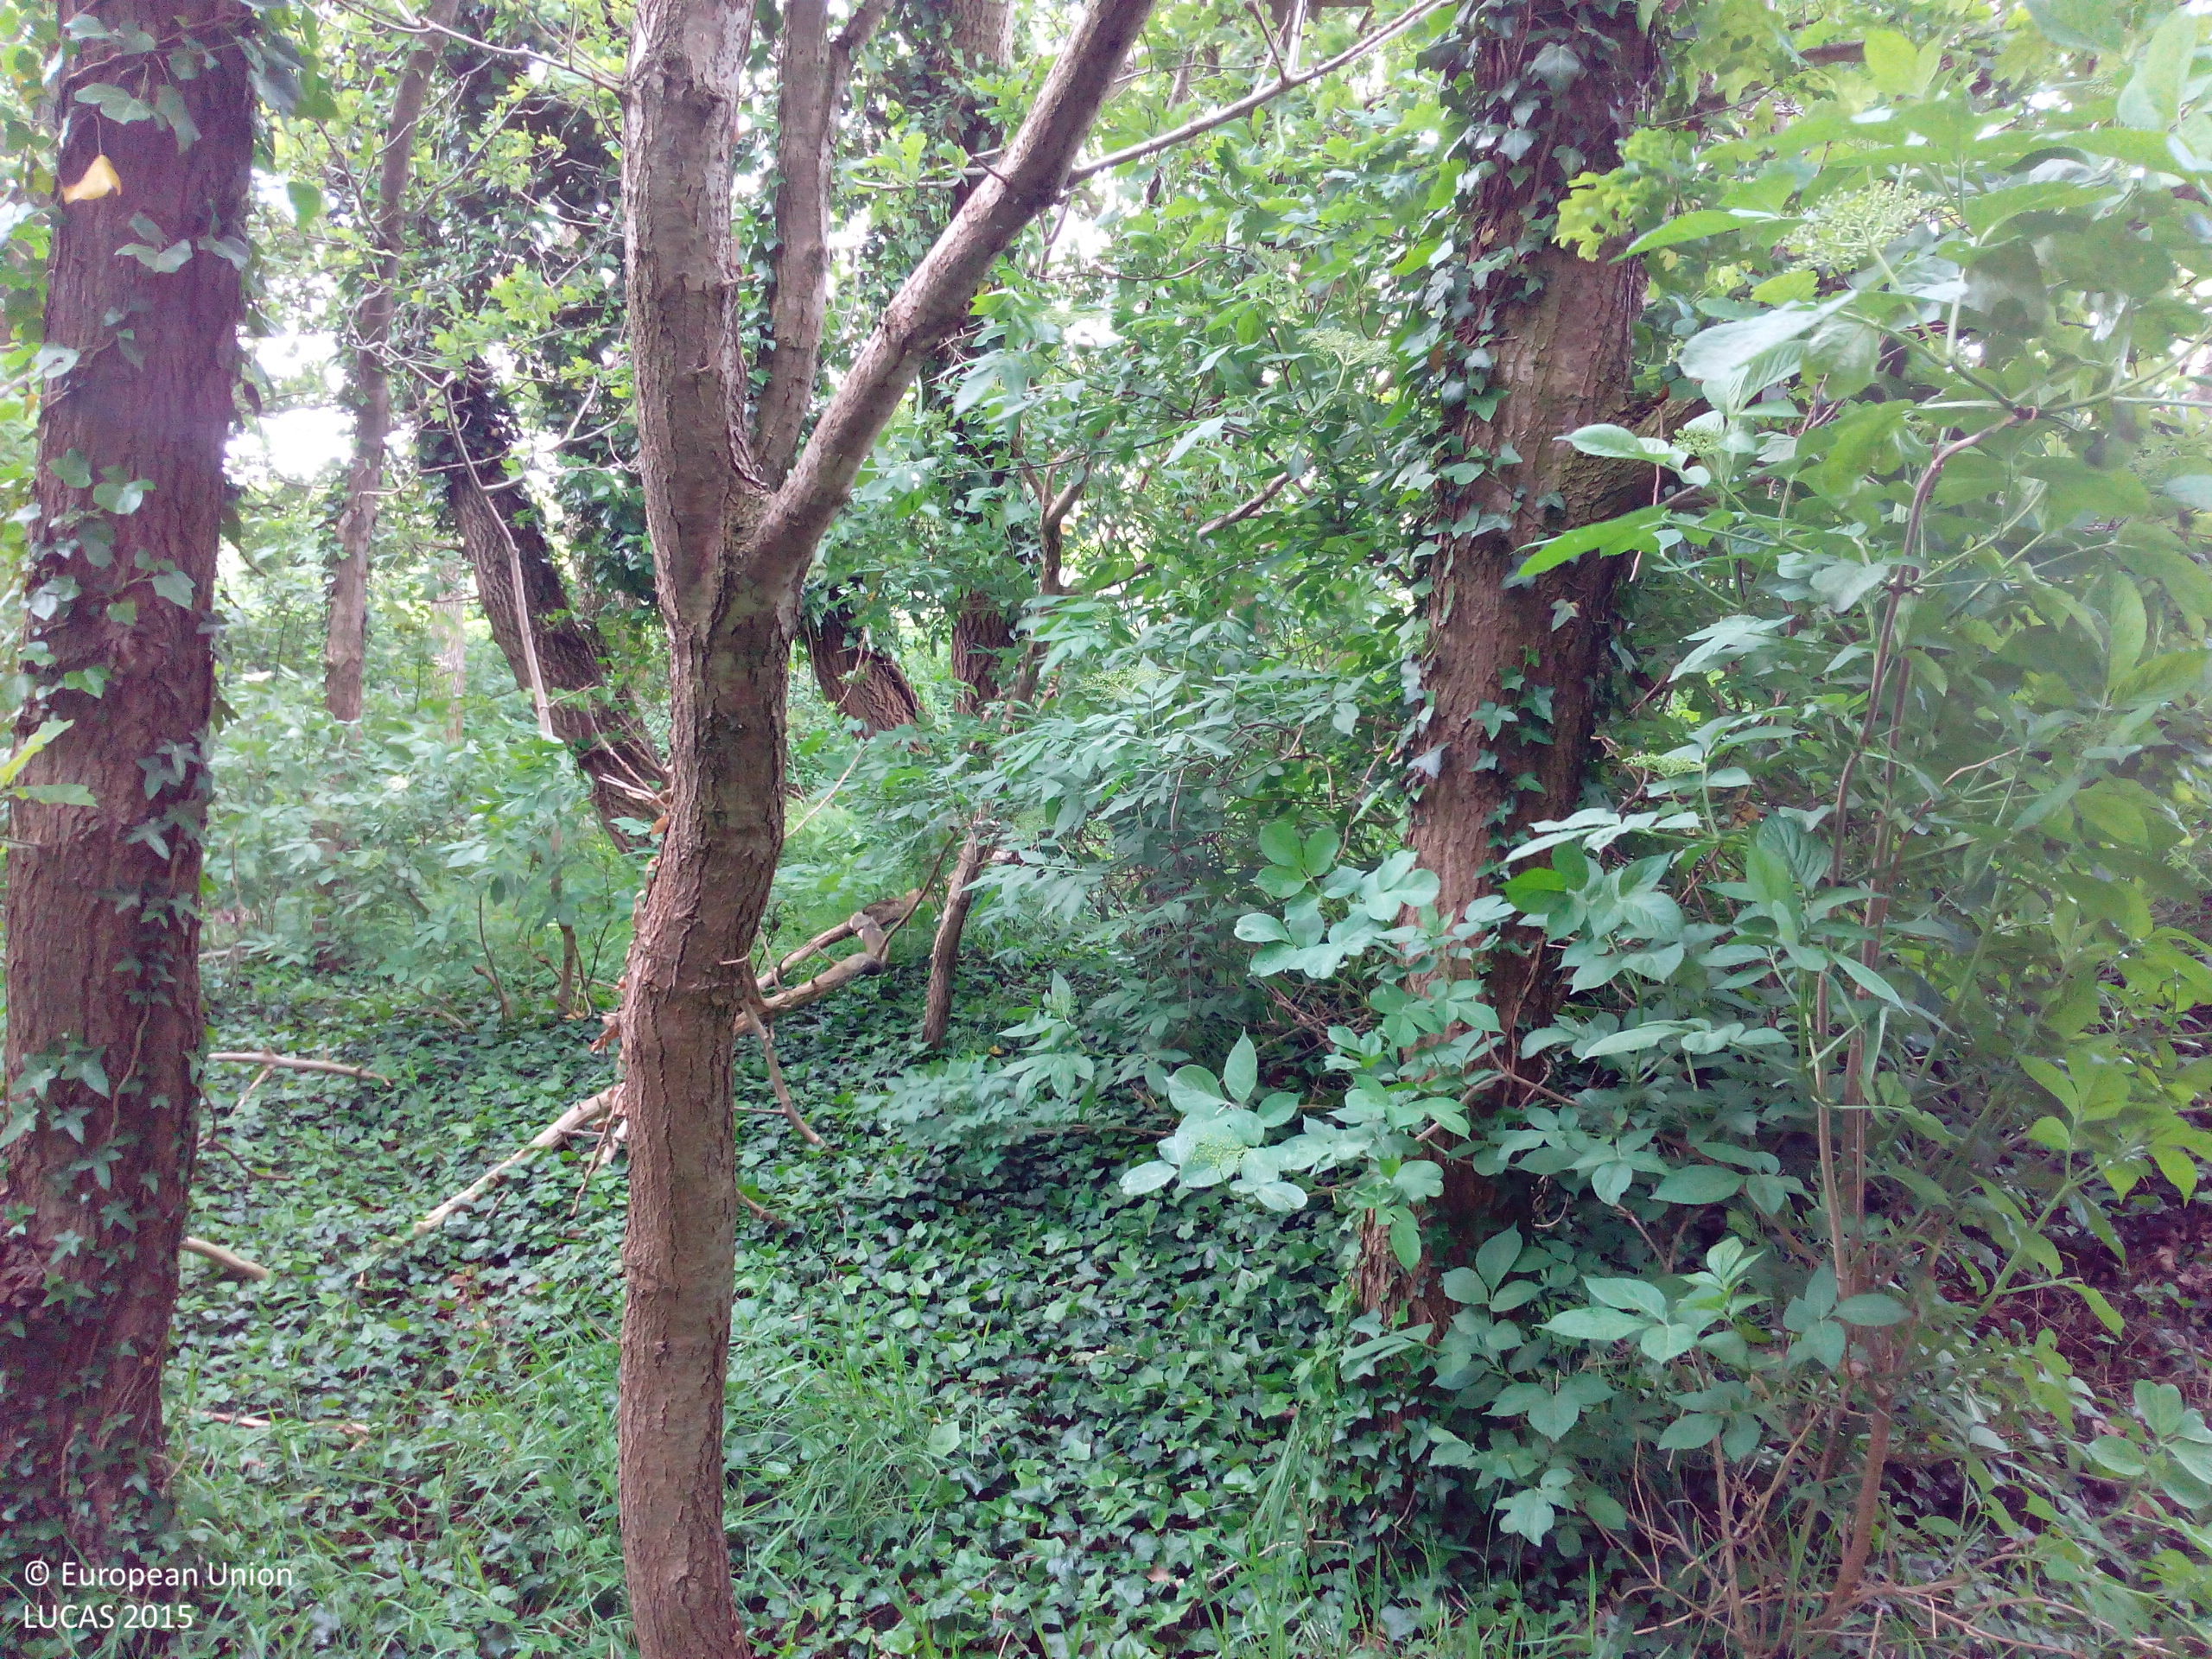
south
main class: Woodland
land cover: Broadleaved woodland
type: acidophilous oak and oak-birch forest
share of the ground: > 75 %
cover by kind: broadleaved forest trees 80 %, shrubs 10 %, herbaceous plants 10 %
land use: Forestry
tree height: > 5 m
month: May
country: DE
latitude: 52.6726
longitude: 11.5819
